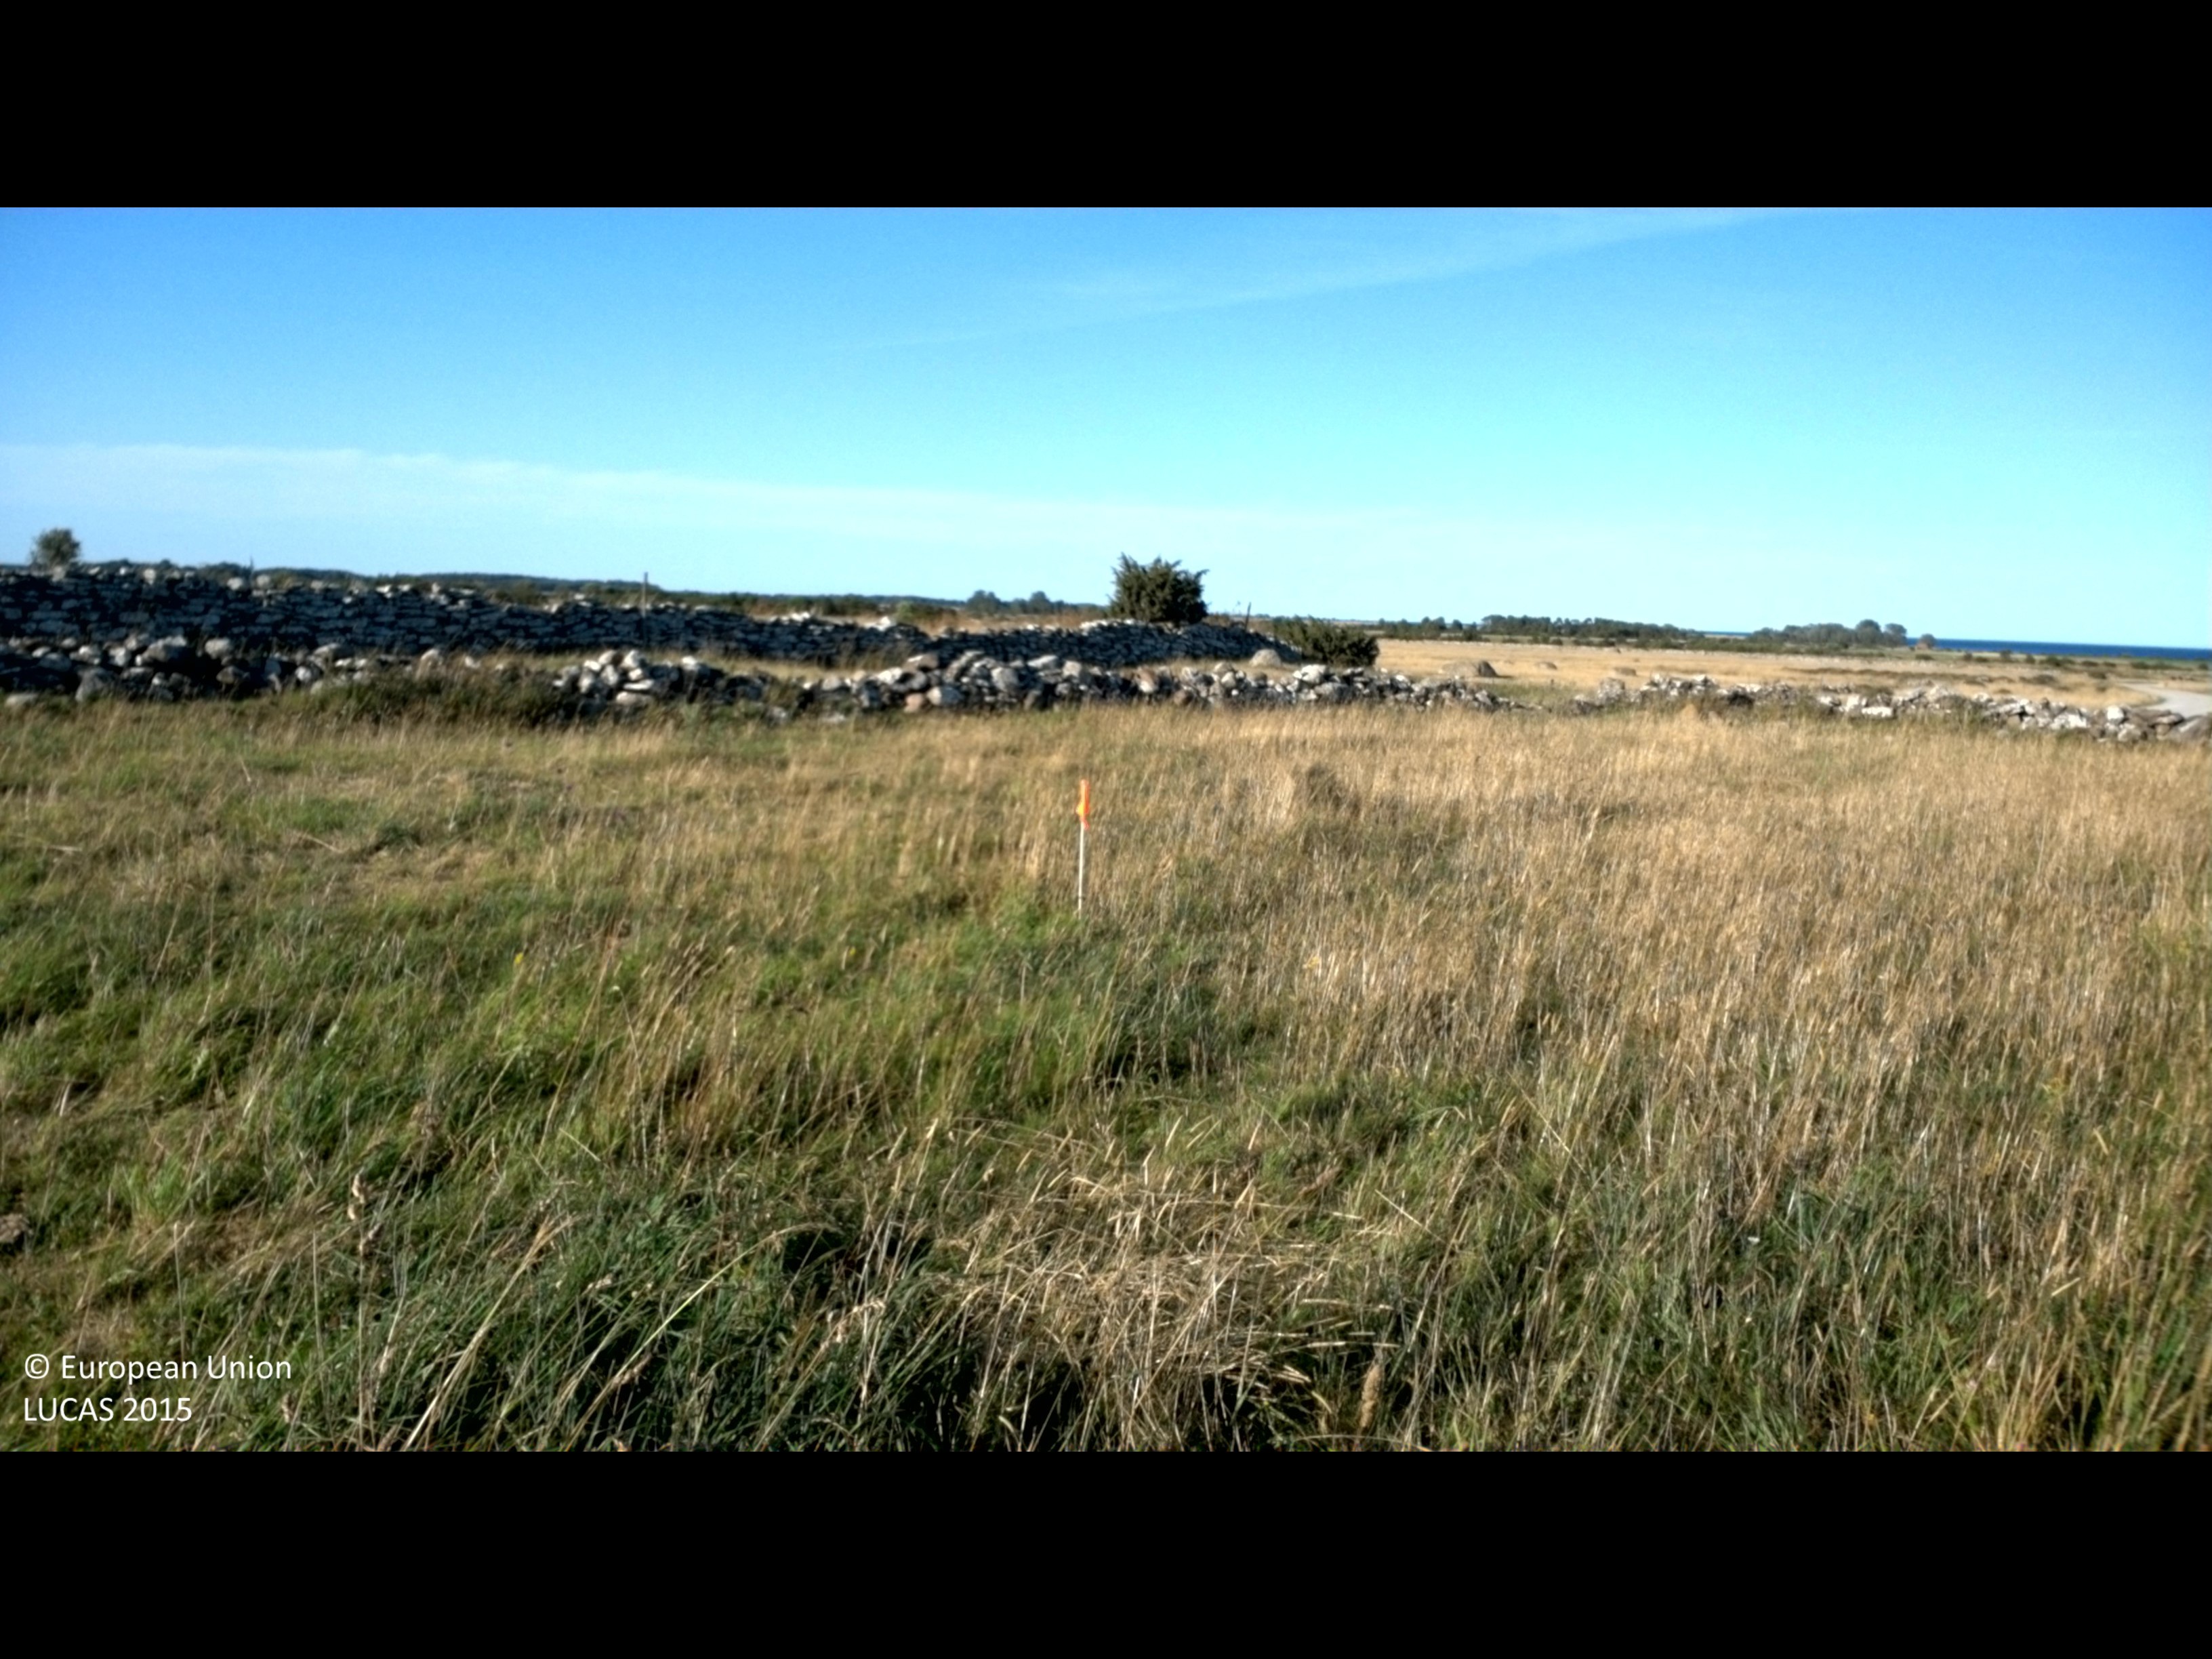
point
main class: Grassland
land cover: Grassland without tree/shrub cover
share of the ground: > 75 %
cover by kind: herbaceous plants 100 %
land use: Agriculture (excluding fallow land and kitchen gardens)
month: July
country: SE
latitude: 56.5580
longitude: 16.6240
